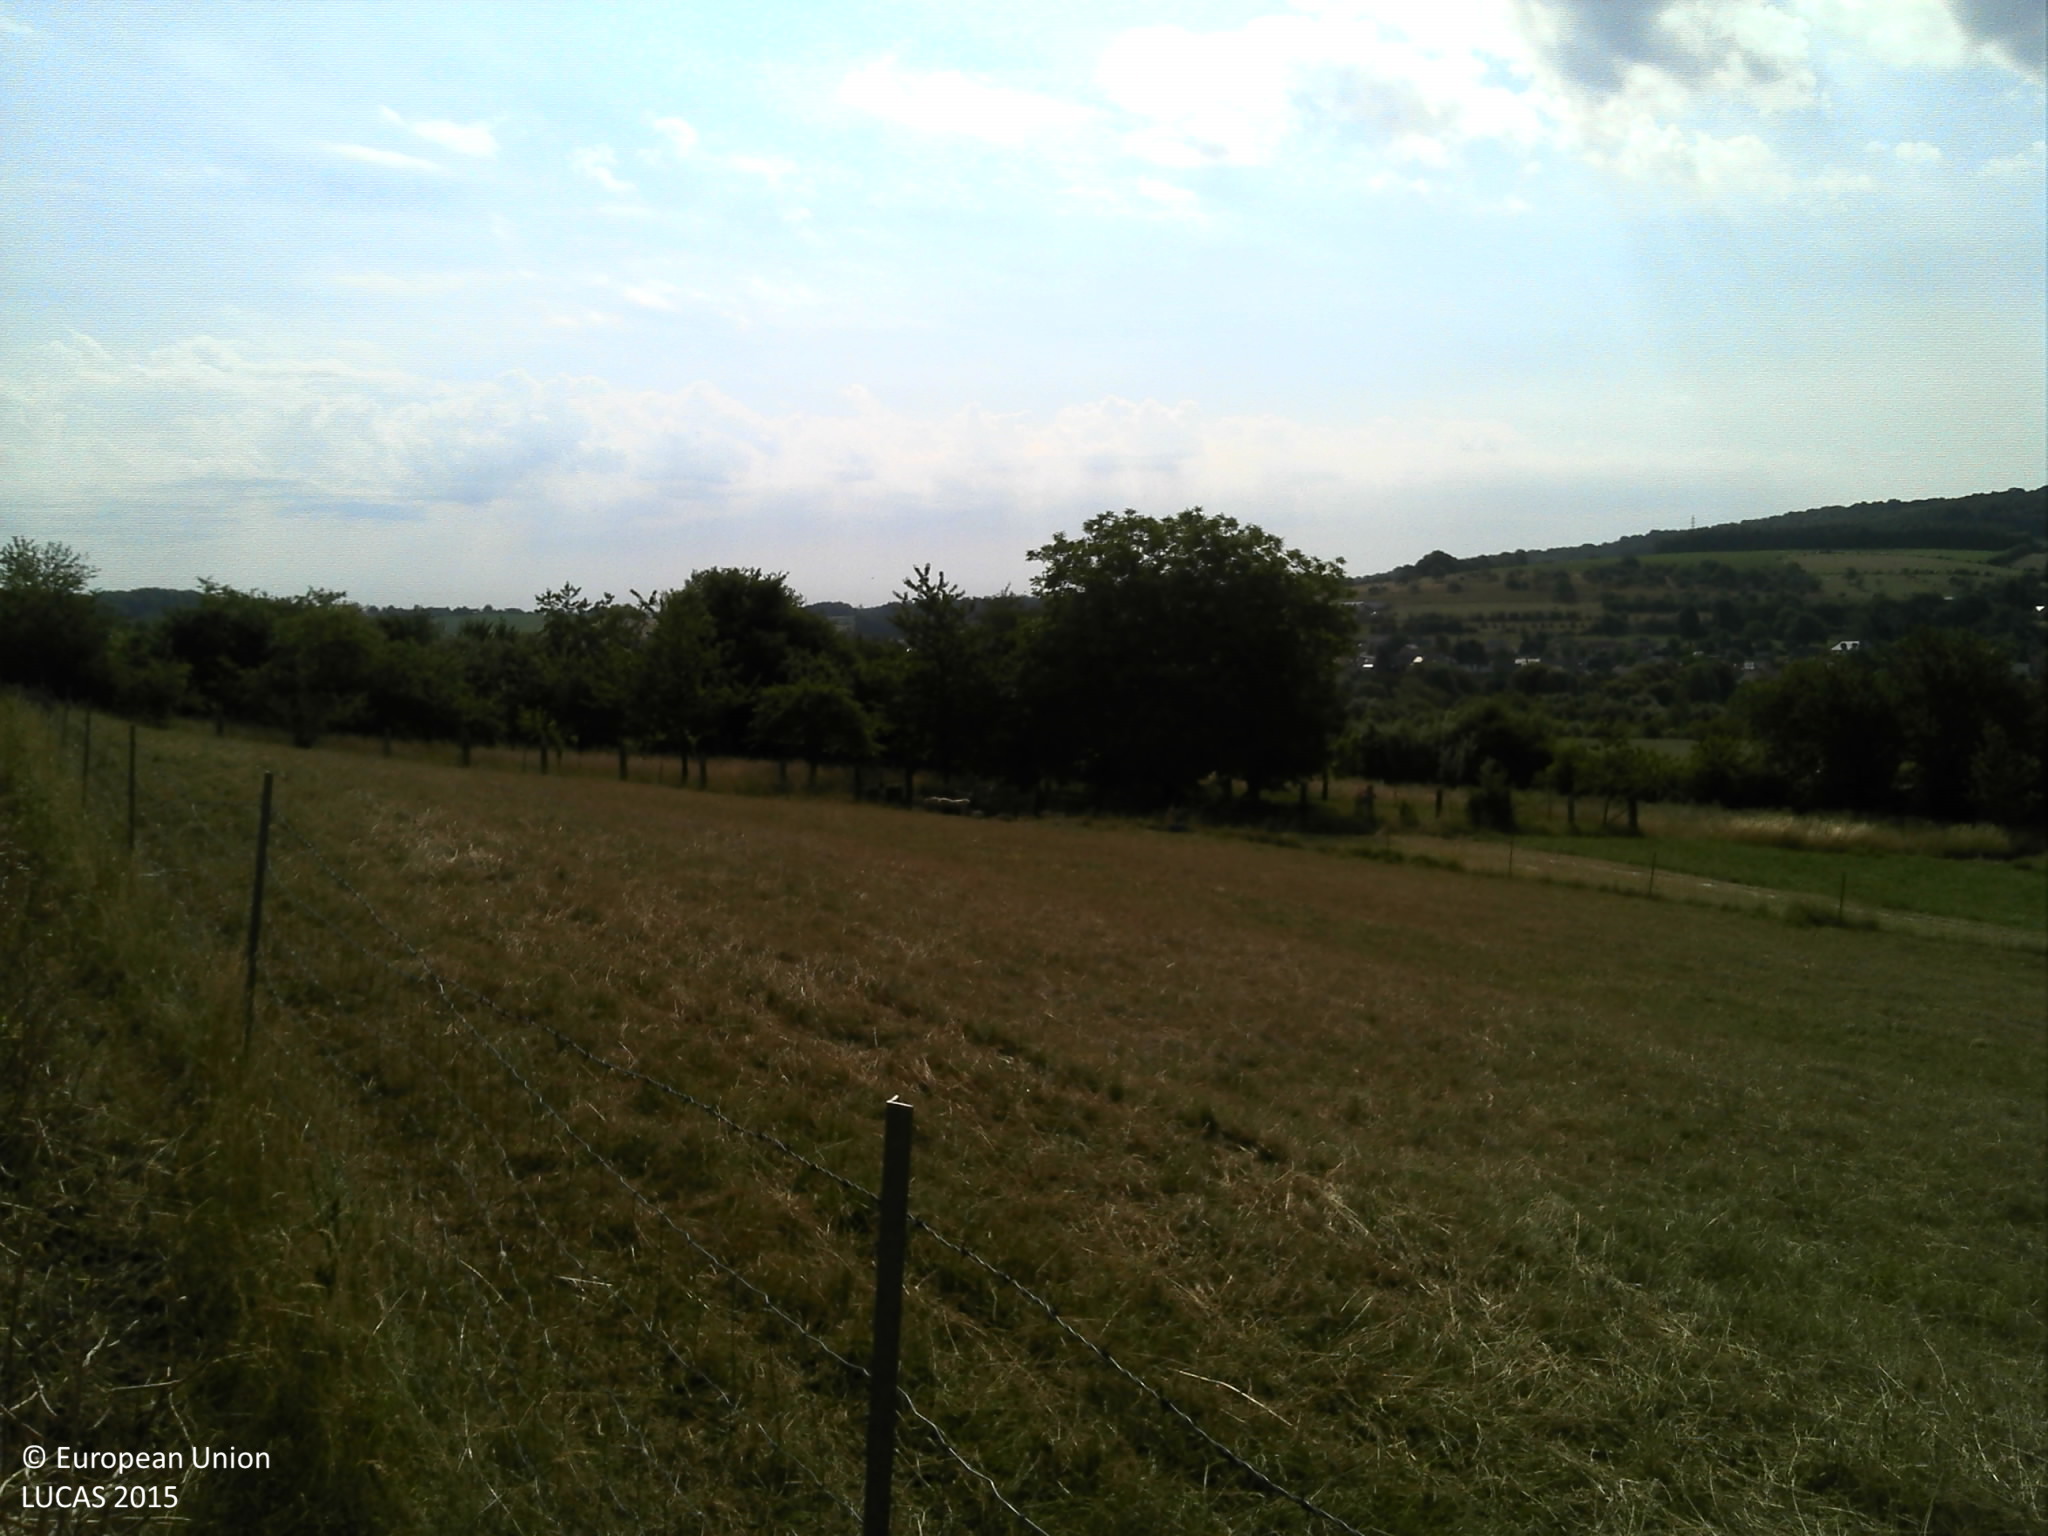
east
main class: Cropland
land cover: Rape and turnip rape
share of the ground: > 75 %
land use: Agriculture (excluding fallow land and kitchen gardens)
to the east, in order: Rape and turnip rape; Fences; Grassland without tree/shrub cover; Fences; Grass margins; Tracks; Fences; Apple fruit; Fences; Grassland without tree/shrub cover; Electric lines; Grassland without tree/shrub cover; Grassland with sparse tree/shrub cover; Grassland without tree/shrub cover
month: July
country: FR
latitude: 49.7000
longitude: 4.6865
